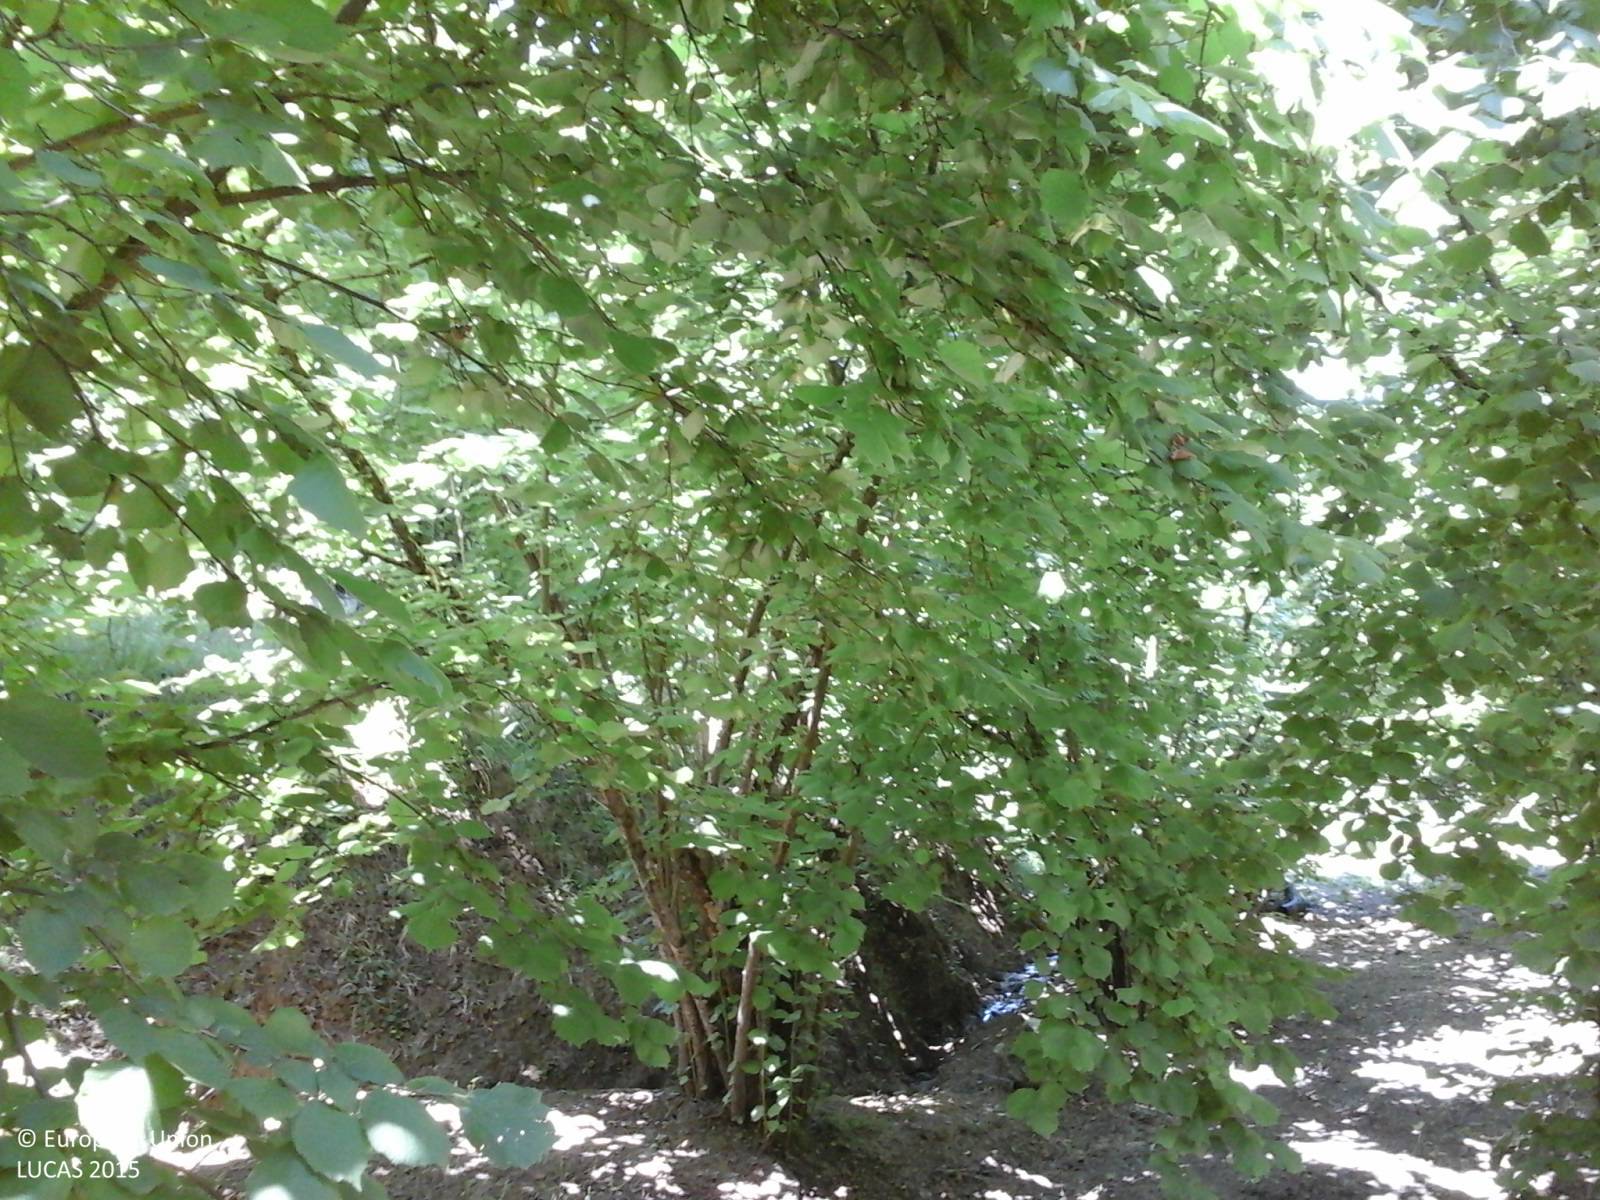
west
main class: Cropland
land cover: Nuts trees
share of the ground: > 75 %
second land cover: Other bare soil
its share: > 75 %
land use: Agriculture (excluding fallow land and kitchen gardens)
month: June
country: IT
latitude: 42.4852
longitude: 12.2189
